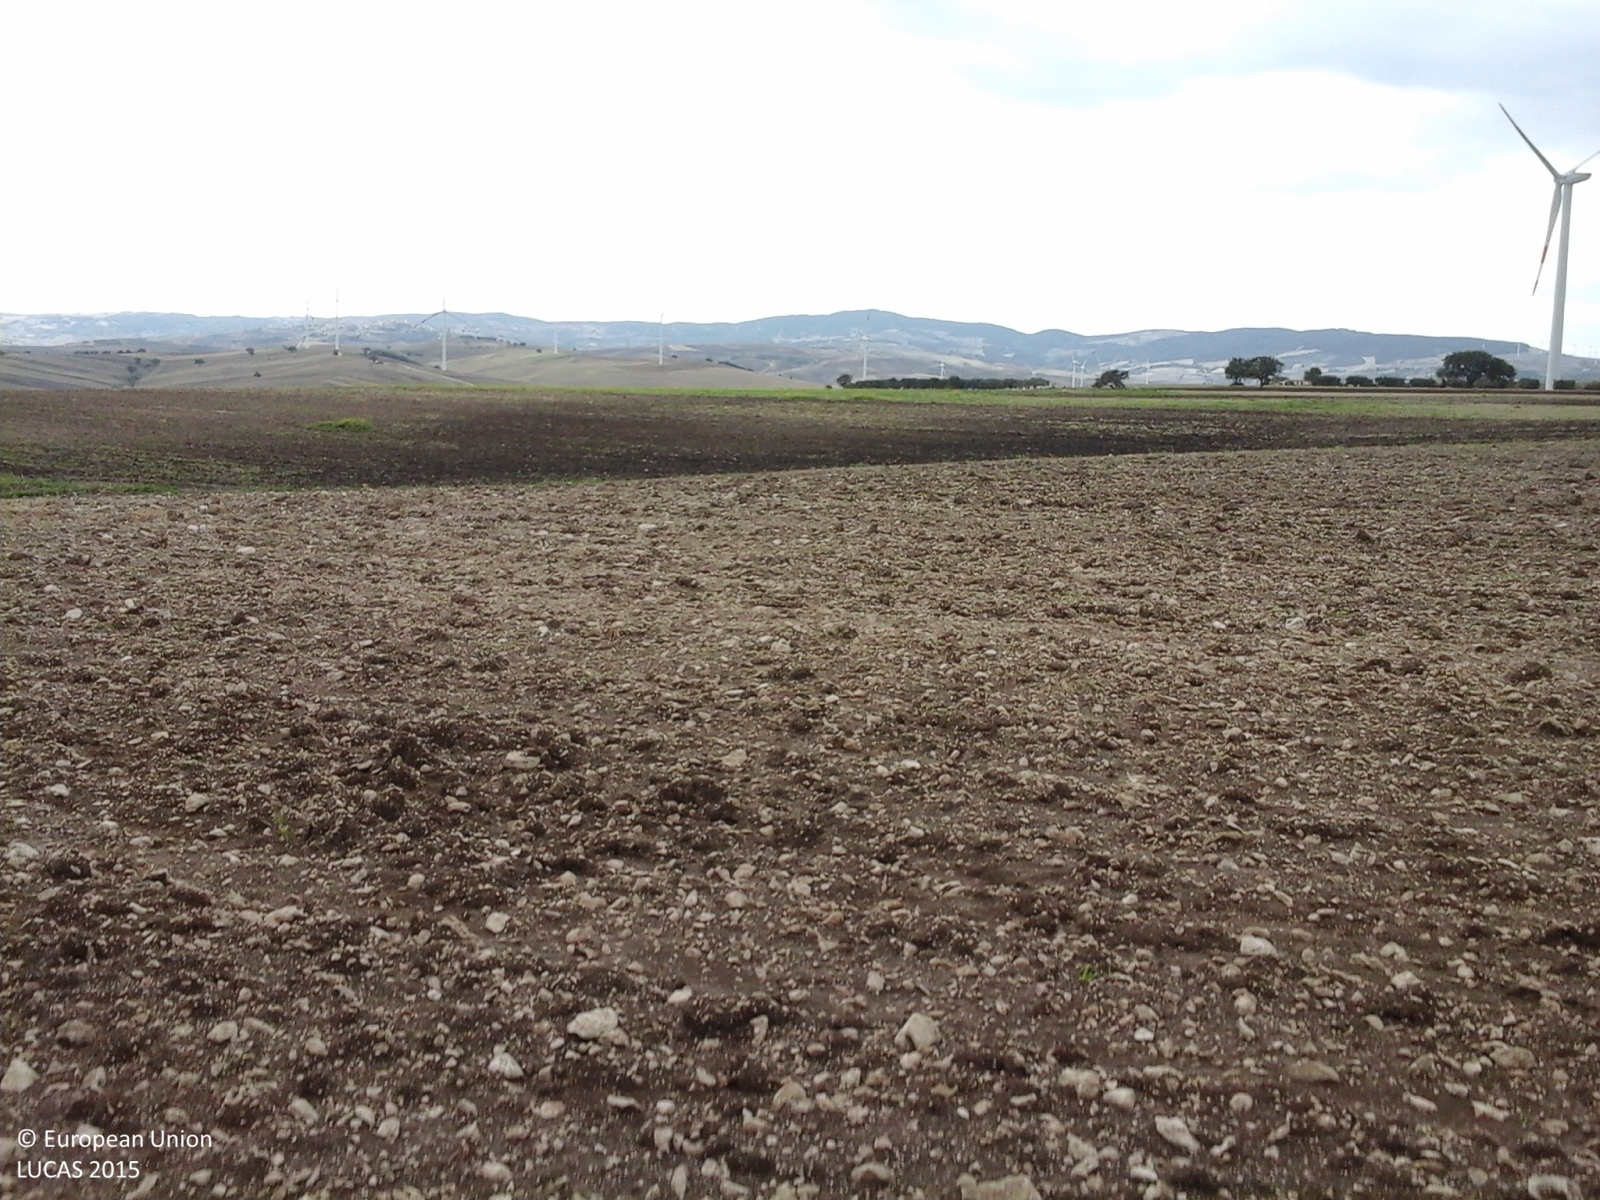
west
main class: Cropland
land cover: Durum wheat
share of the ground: > 75 %
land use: Agriculture (excluding fallow land and kitchen gardens)
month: October
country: IT
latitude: 41.5250
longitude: 15.1957
